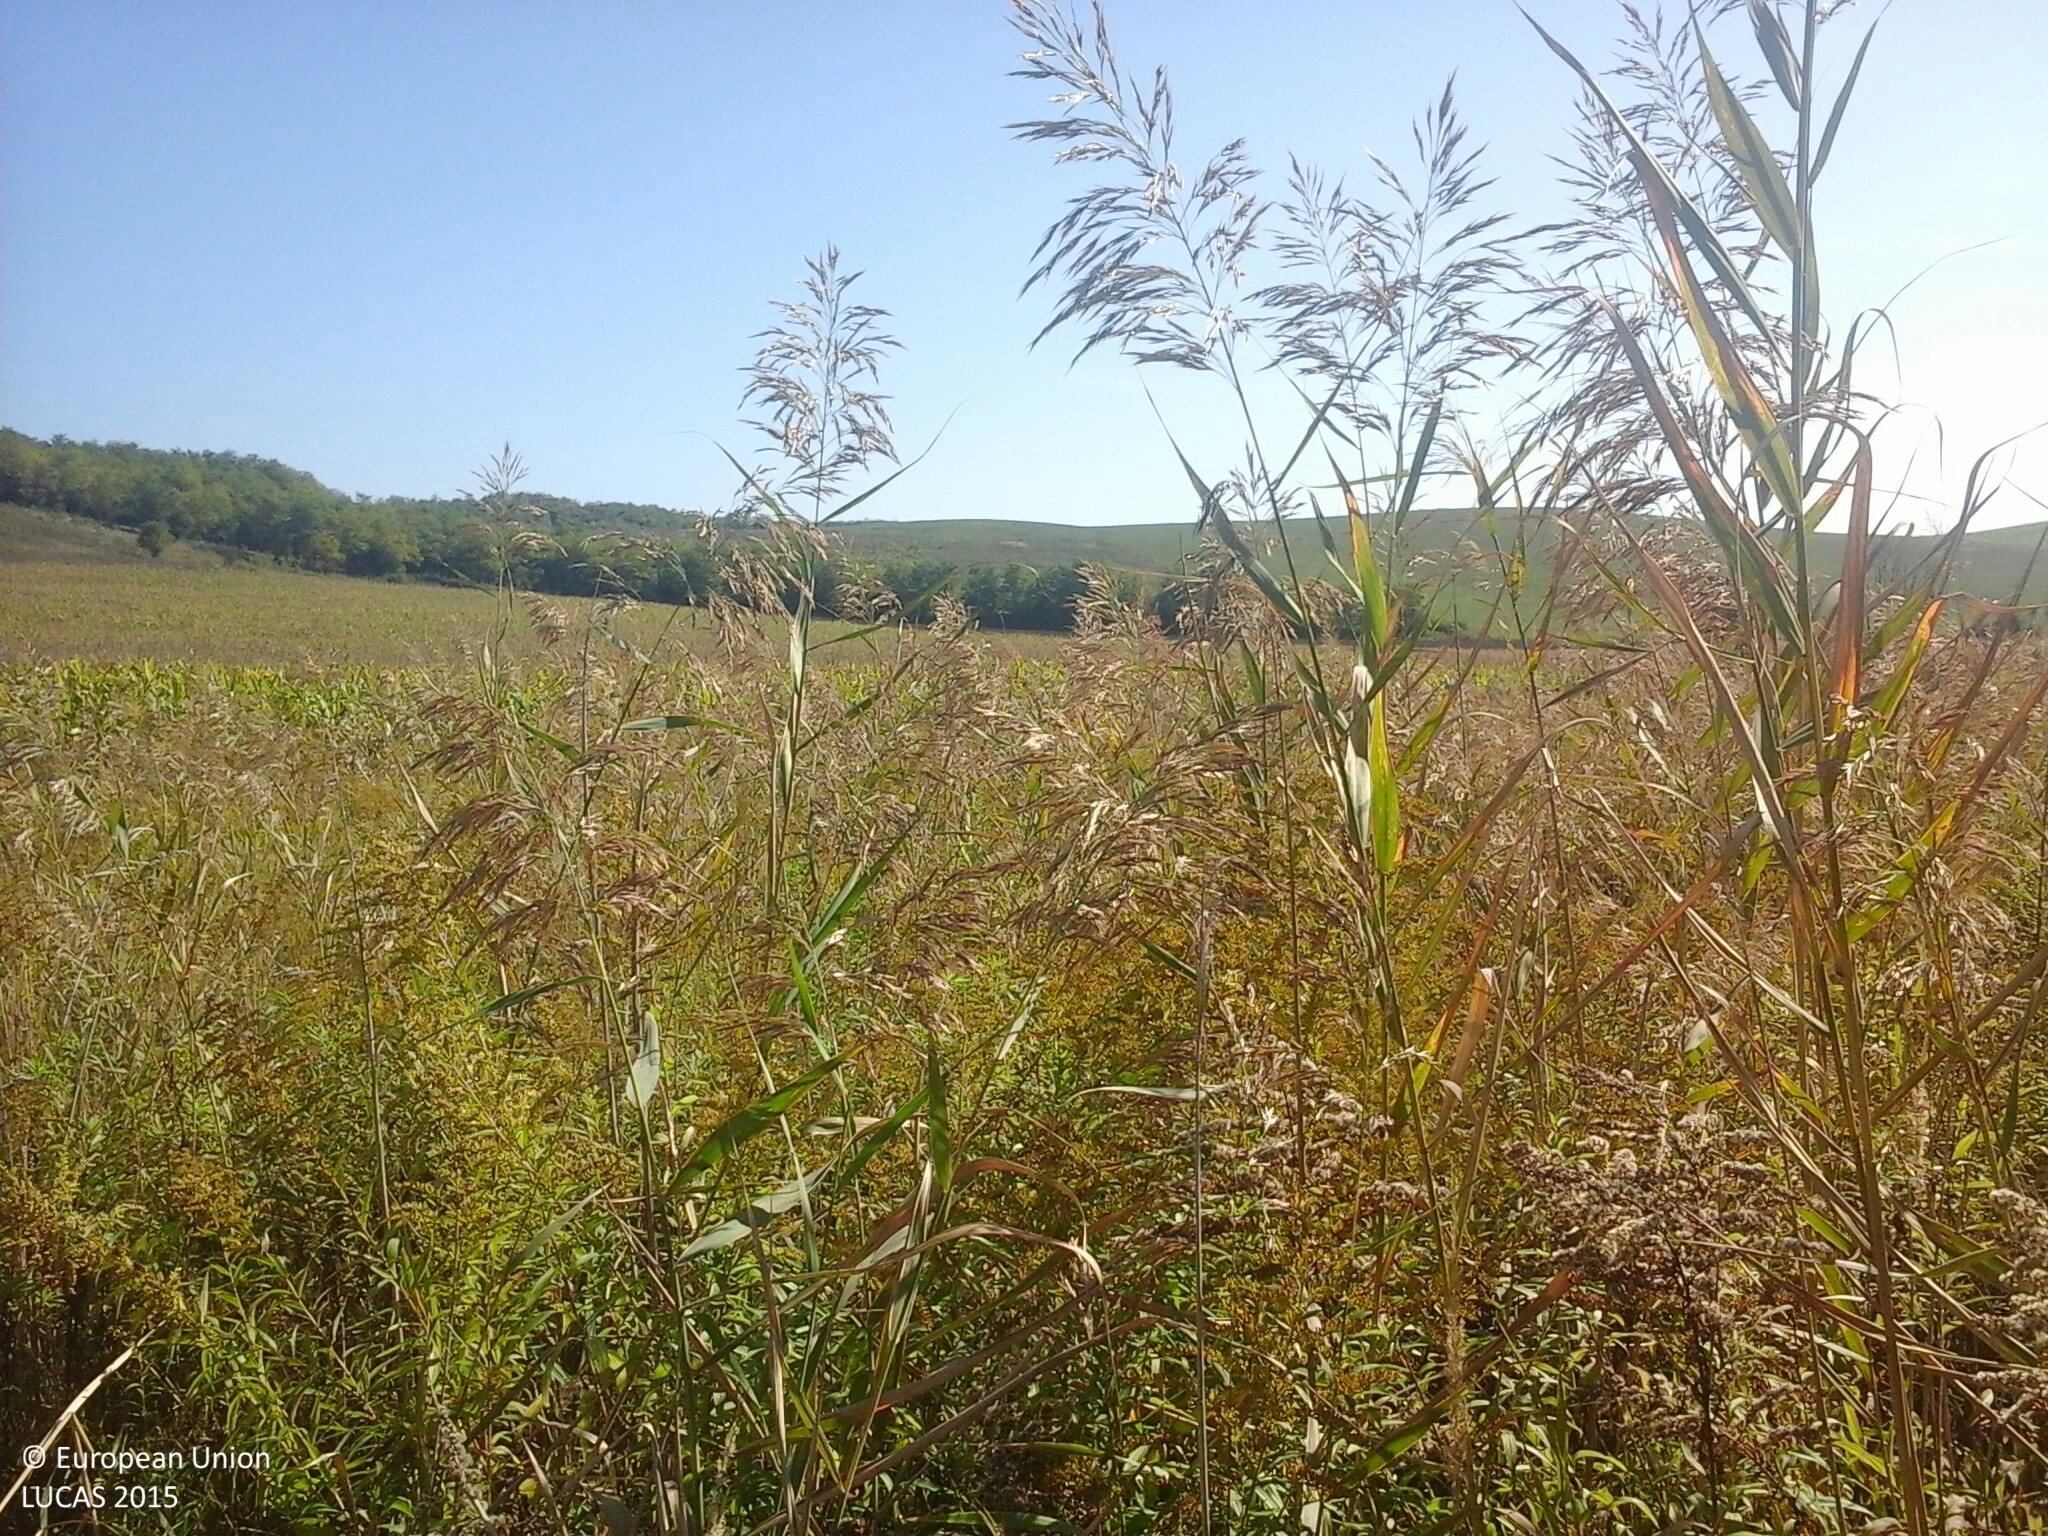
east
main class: Grassland
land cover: Spontaneously vegetated surfaces
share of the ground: > 75 %
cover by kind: herbaceous plants 100 %
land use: Abandoned areas
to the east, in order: Spontaneously vegetated surfaces; Tracks; Maize
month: September
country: HU
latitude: 48.0451
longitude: 19.9407
